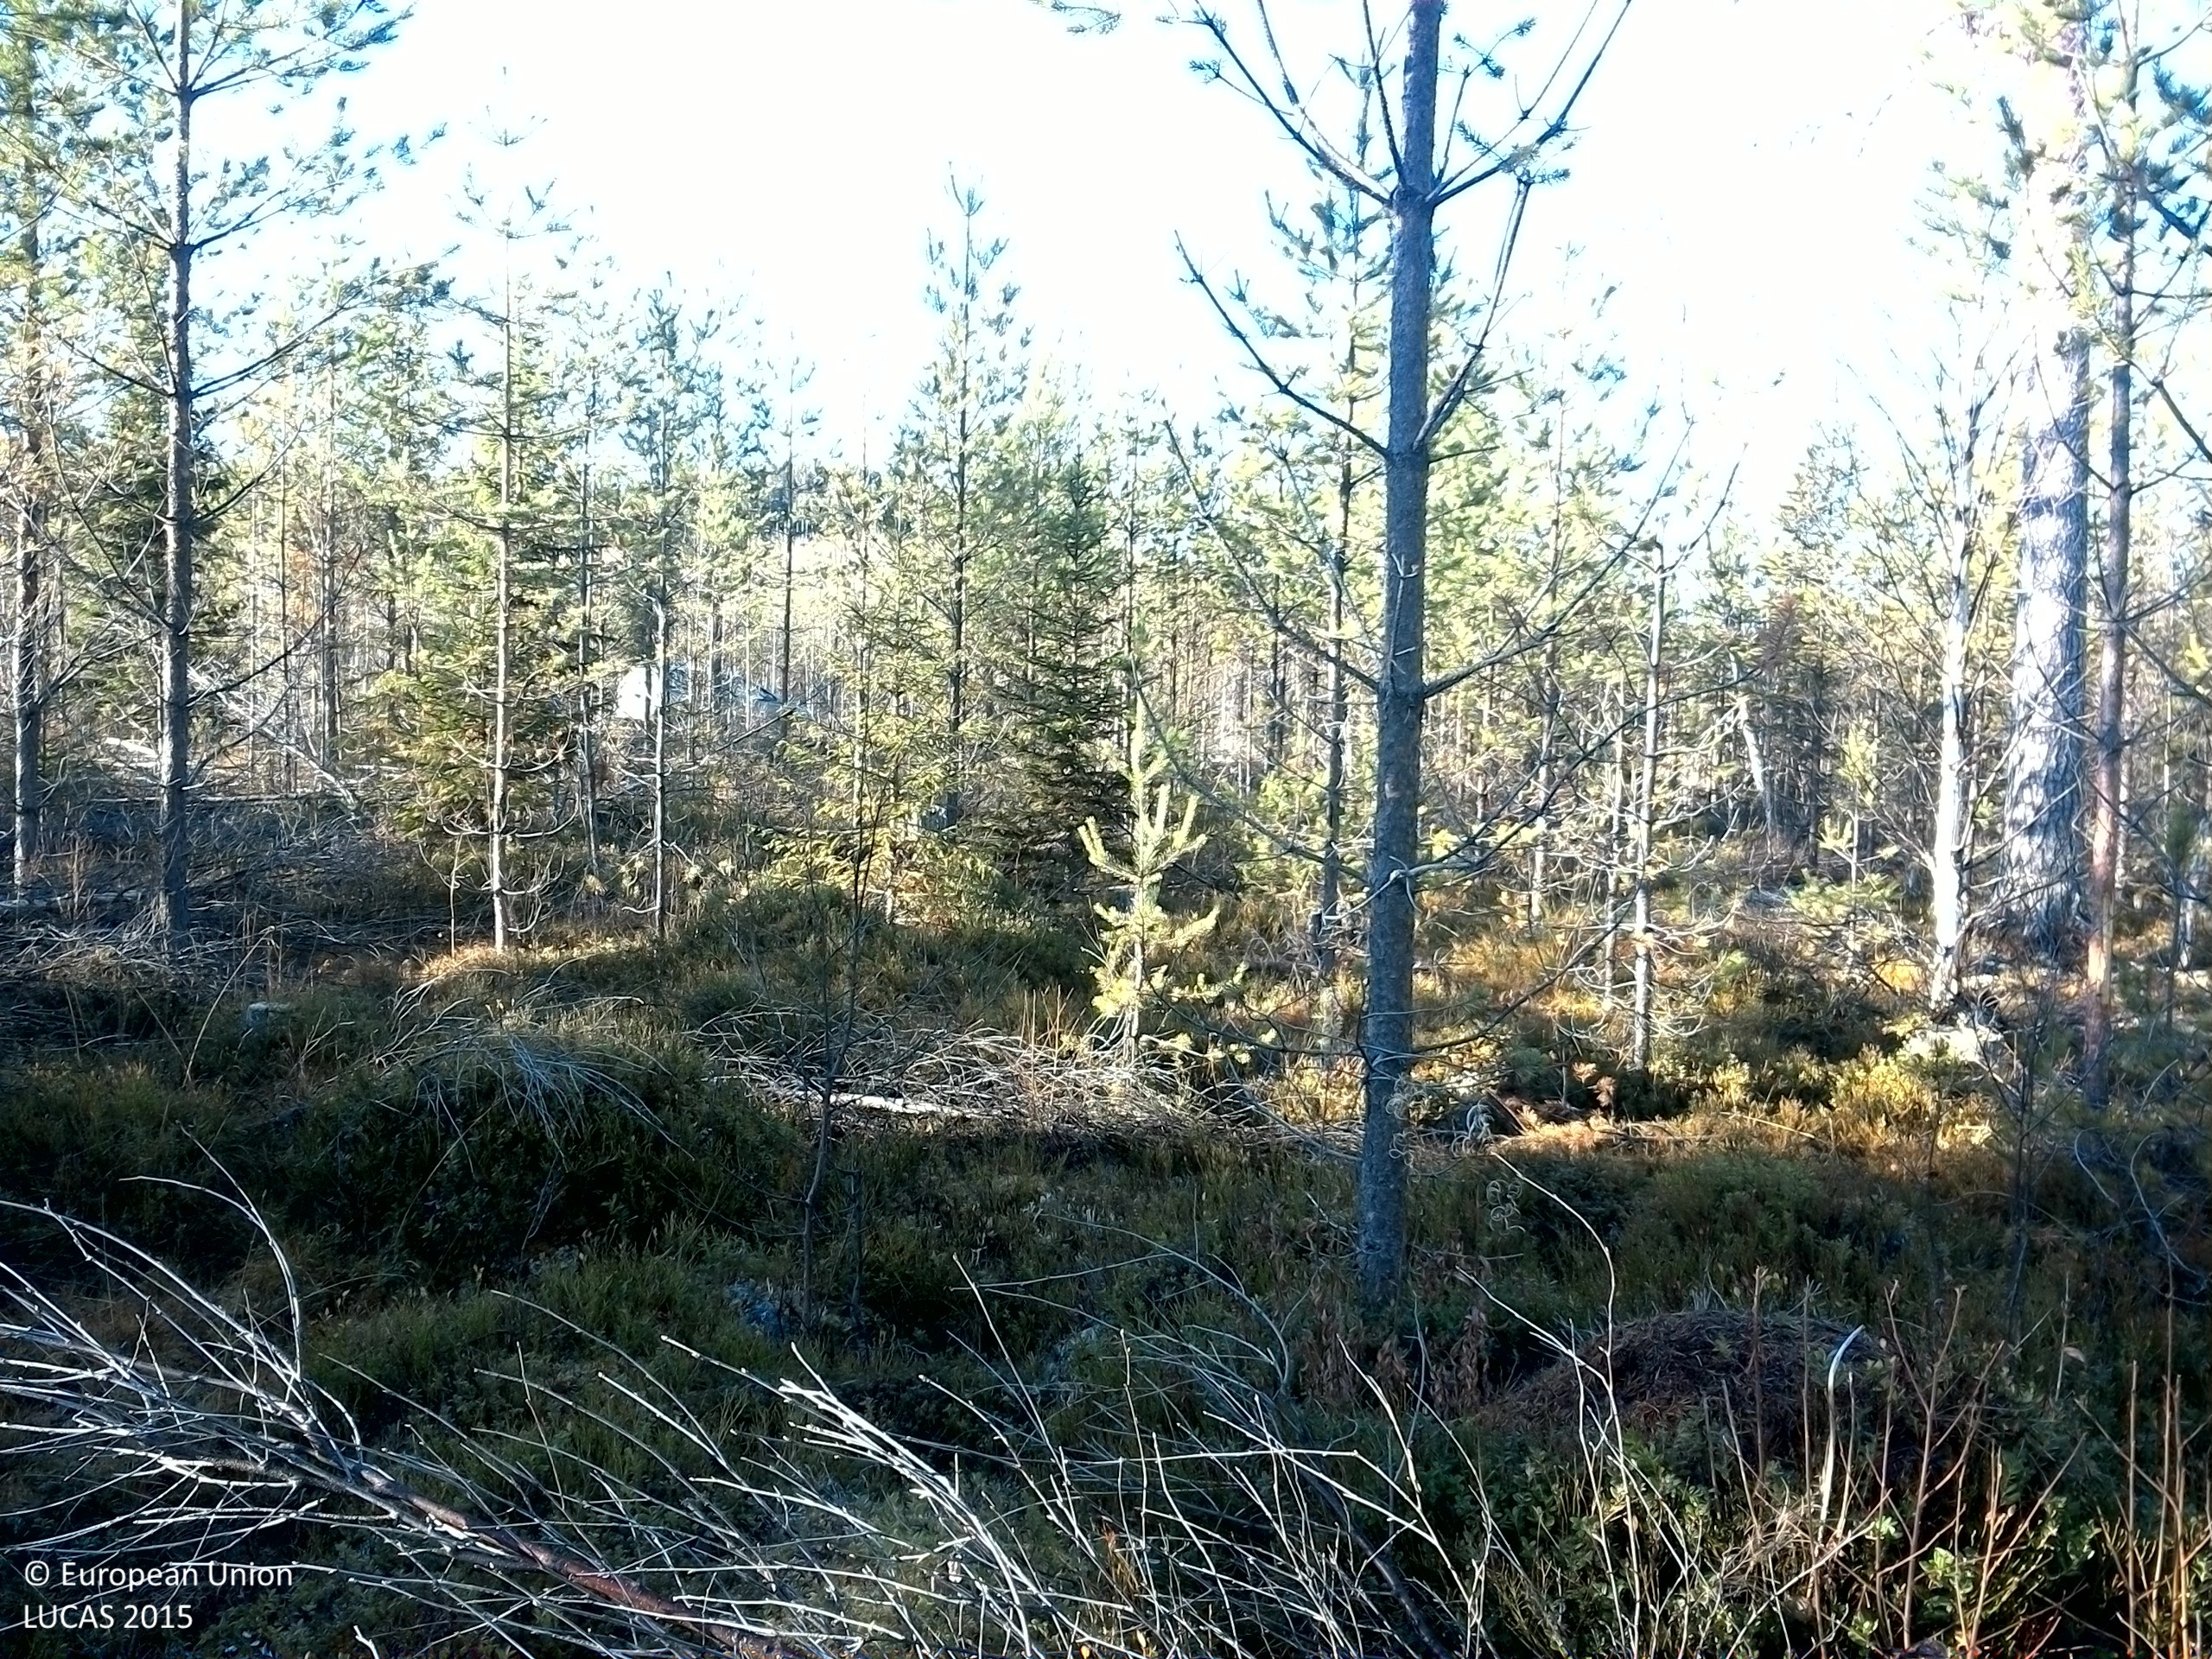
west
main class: Woodland
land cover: Pine dominated coniferous woodland
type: boreal forest
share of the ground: 25 - 50 %
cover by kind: shrubs 40 %, coniferous forest trees 35 %, lichens and mosses 20 %, broadleaved forest trees 5 %
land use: Forestry
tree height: < 5 m
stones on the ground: > 50 %
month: October
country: SE
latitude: 63.7433
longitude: 15.9498
